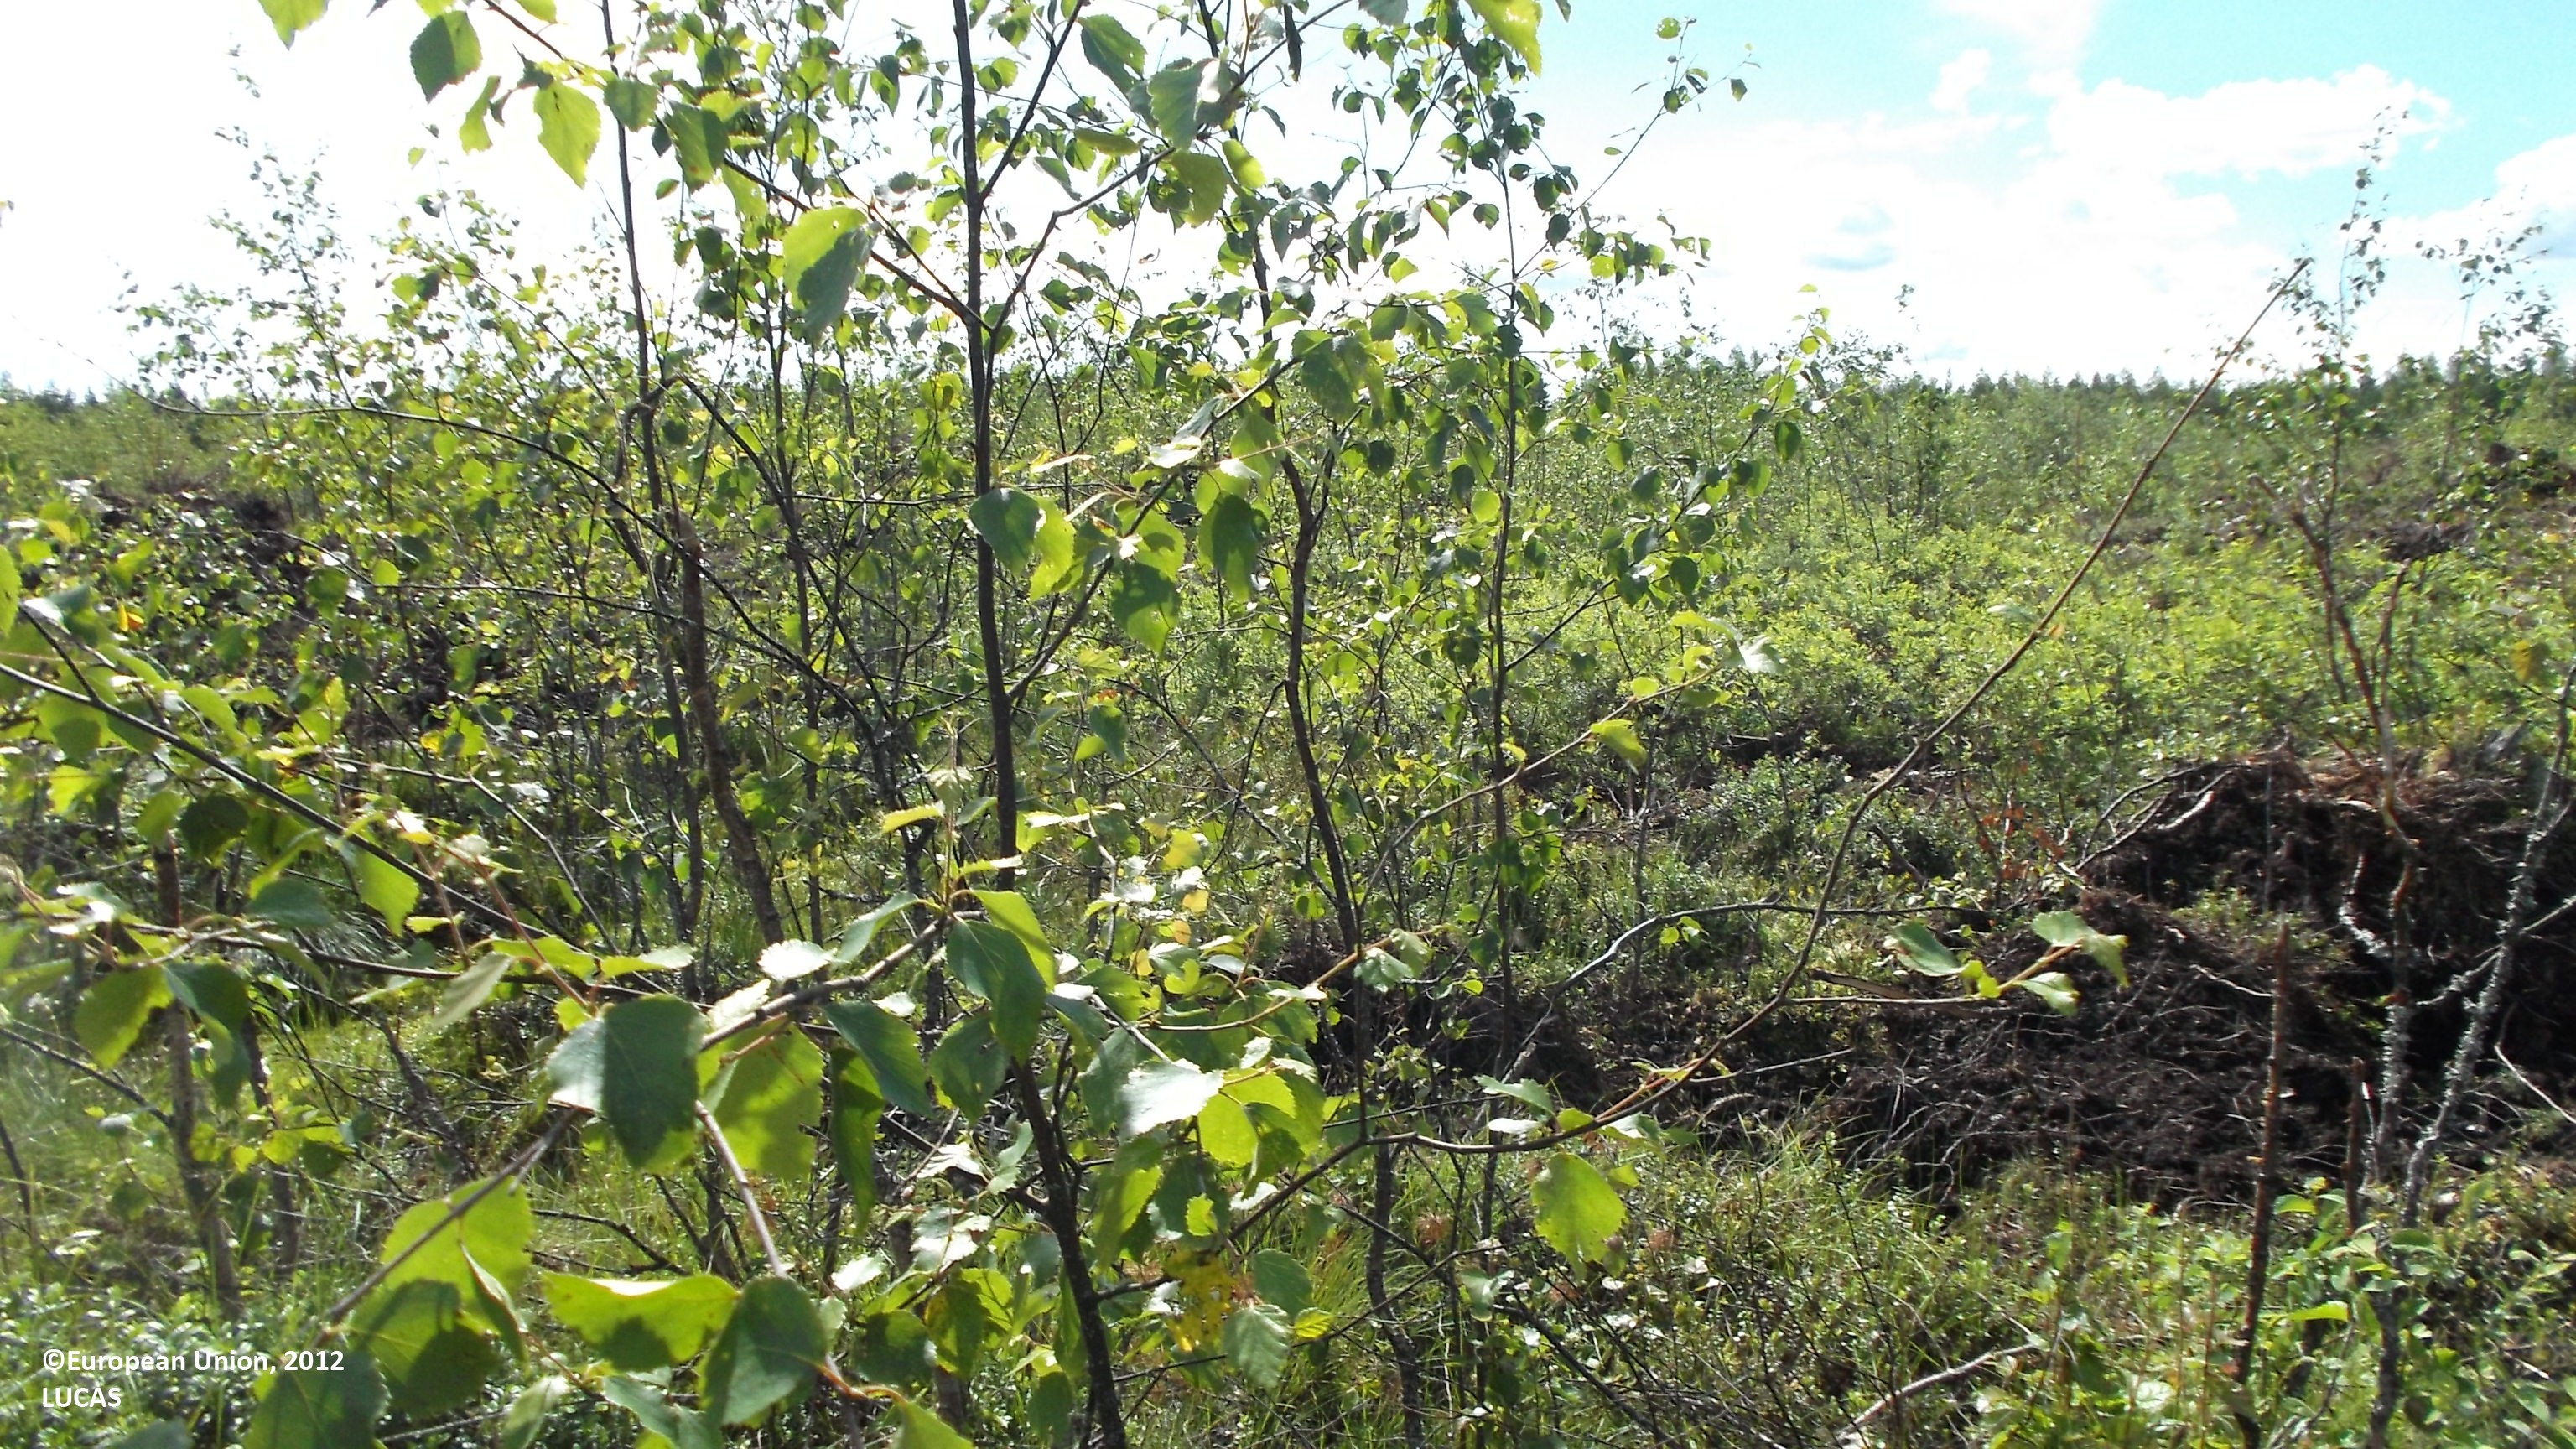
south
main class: Woodland
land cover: Broadleaved woodland
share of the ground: 10 - 25 %
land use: Forestry
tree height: < 5 m
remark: Clear cut
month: July
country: FI
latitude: 63.5197
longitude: 23.9598
